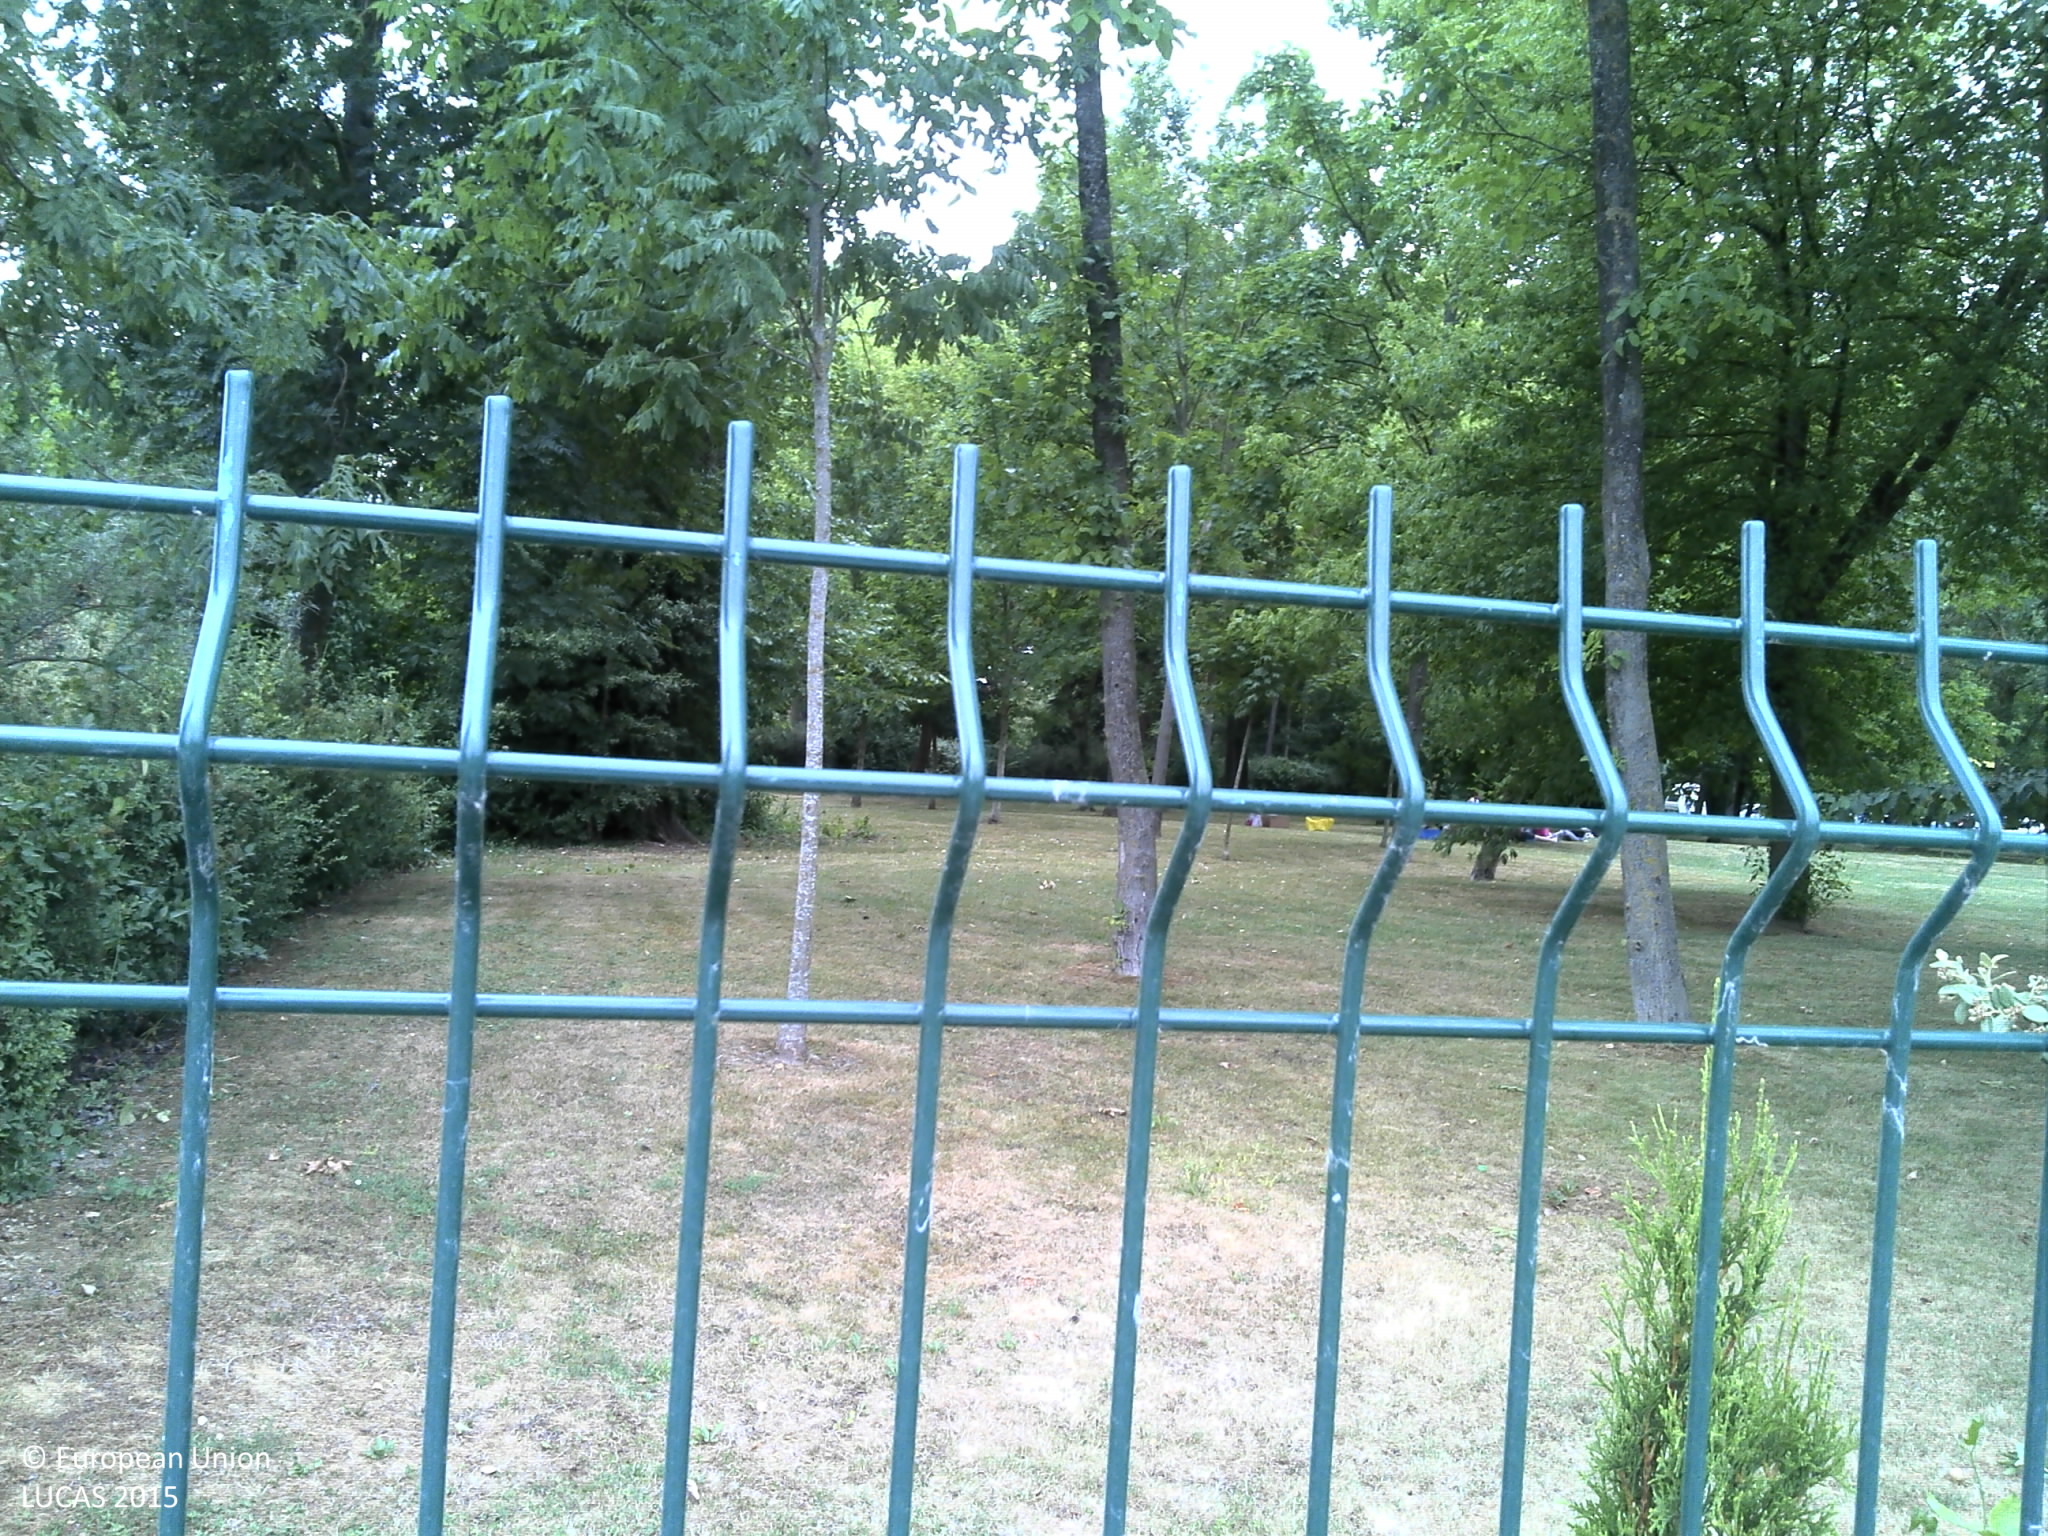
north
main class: Woodland
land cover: Broadleaved woodland
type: floodplain forest
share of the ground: > 75 %
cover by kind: broadleaved forest trees 70 %, herbaceous plants 30 %
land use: Amenities, museums, leisure
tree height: > 5 m
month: July
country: FR
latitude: 48.5996
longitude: 2.4903
